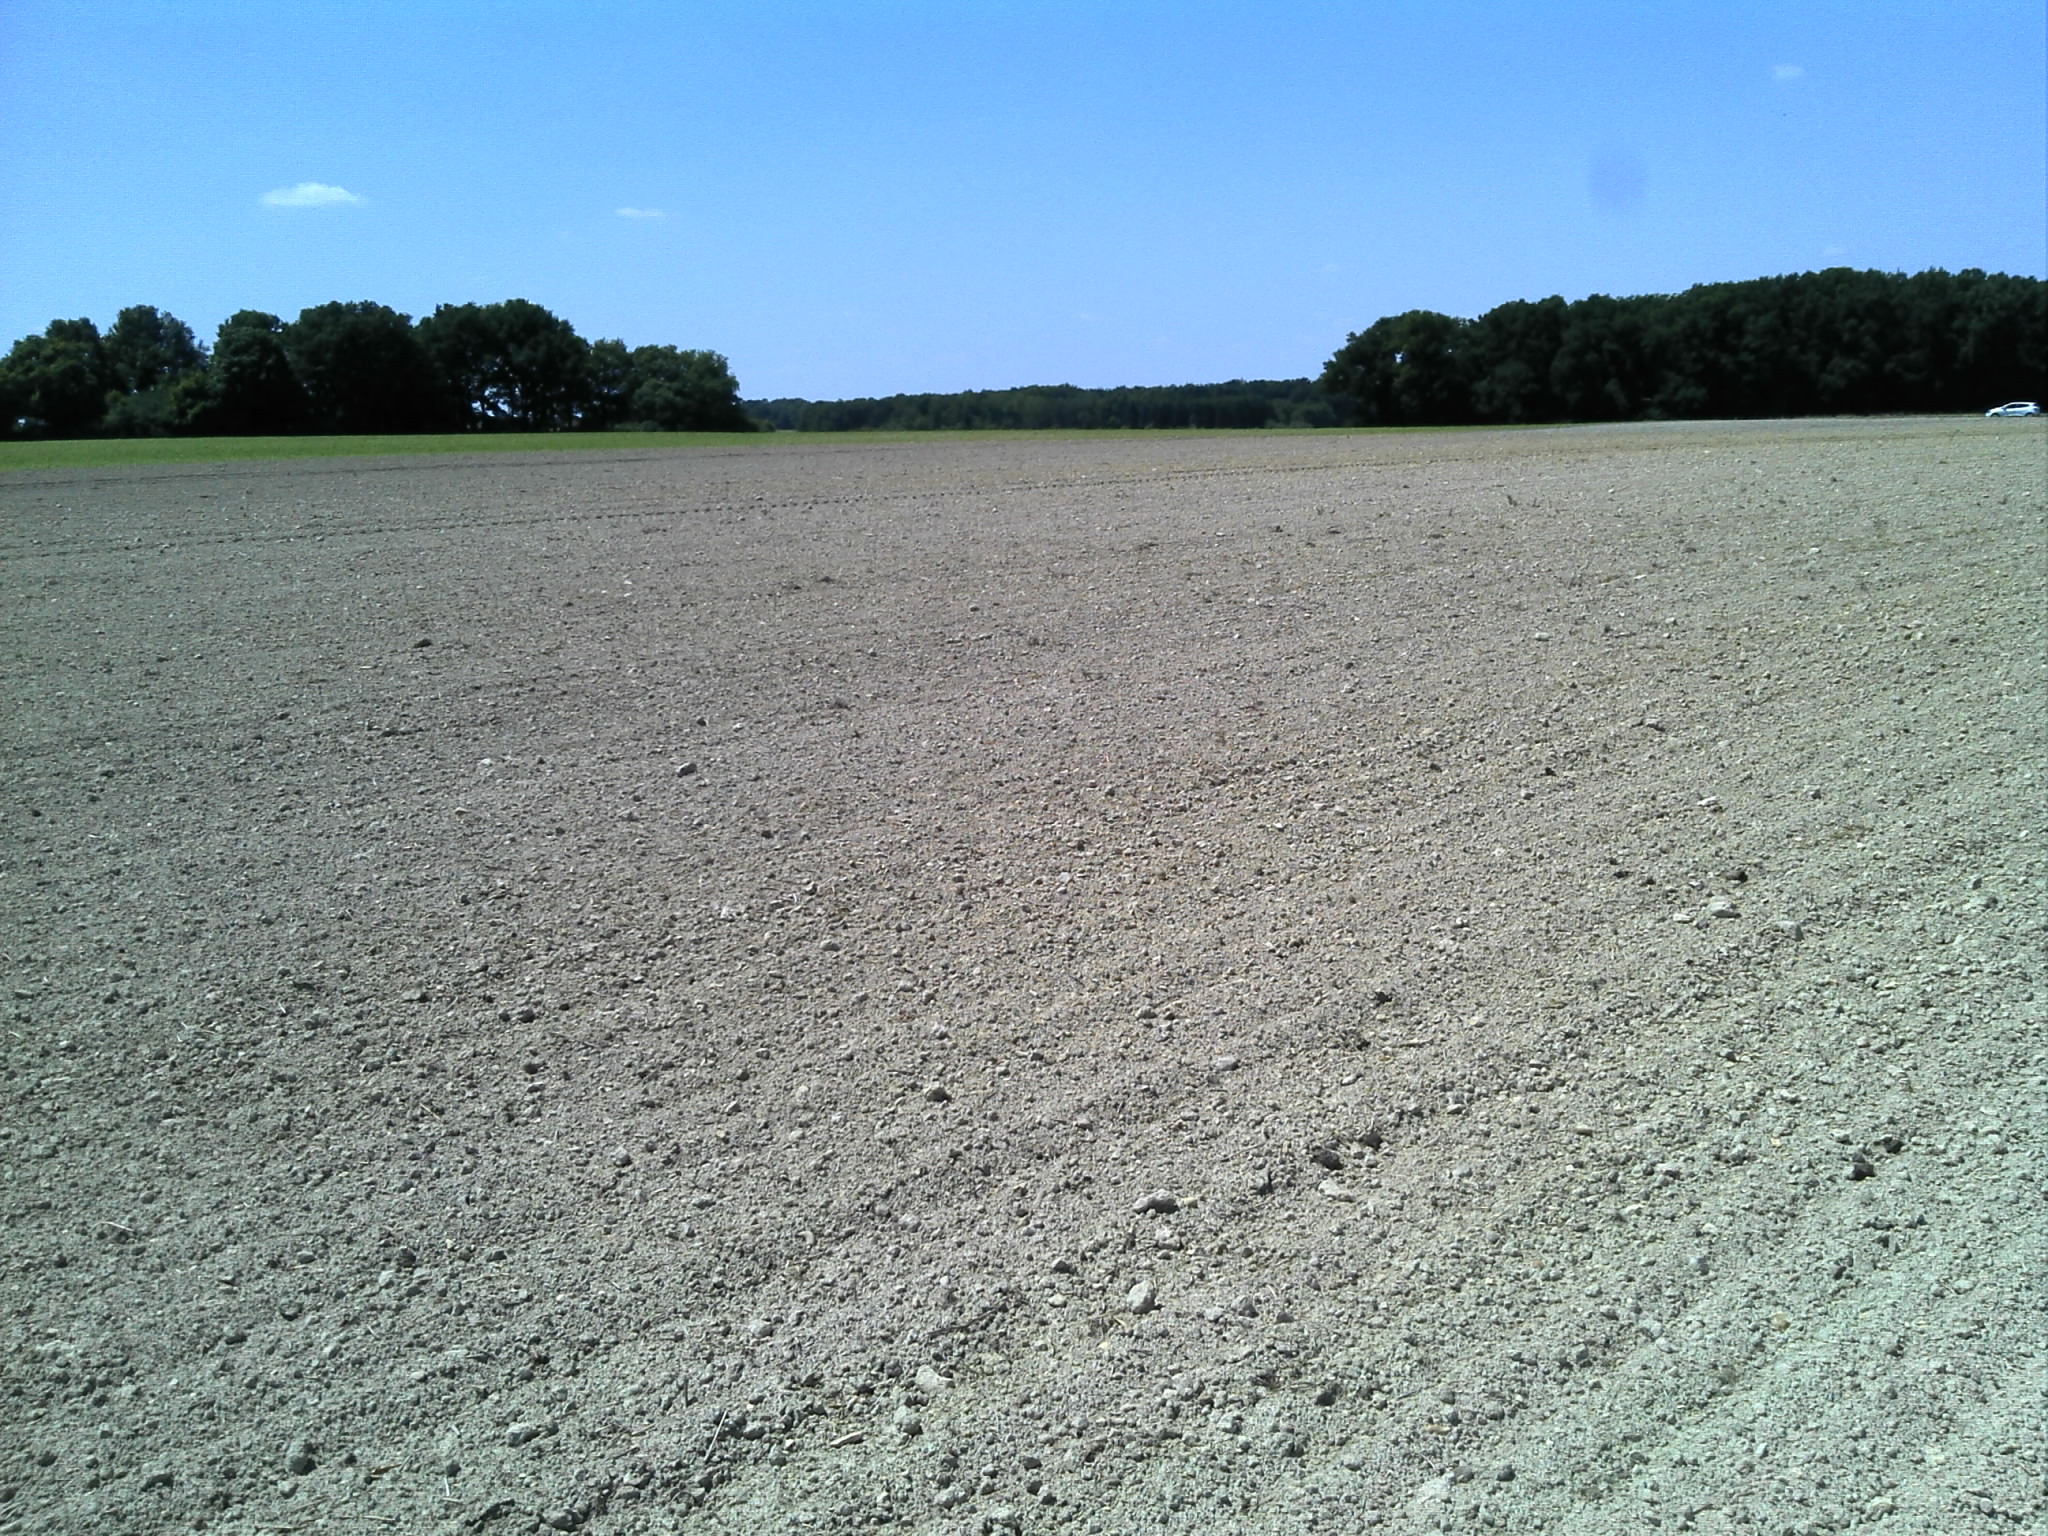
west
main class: Cropland
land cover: Maize
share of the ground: < 10 %
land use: Agriculture (excluding fallow land and kitchen gardens)
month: June
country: FR
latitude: 47.1451
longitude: 1.4021
